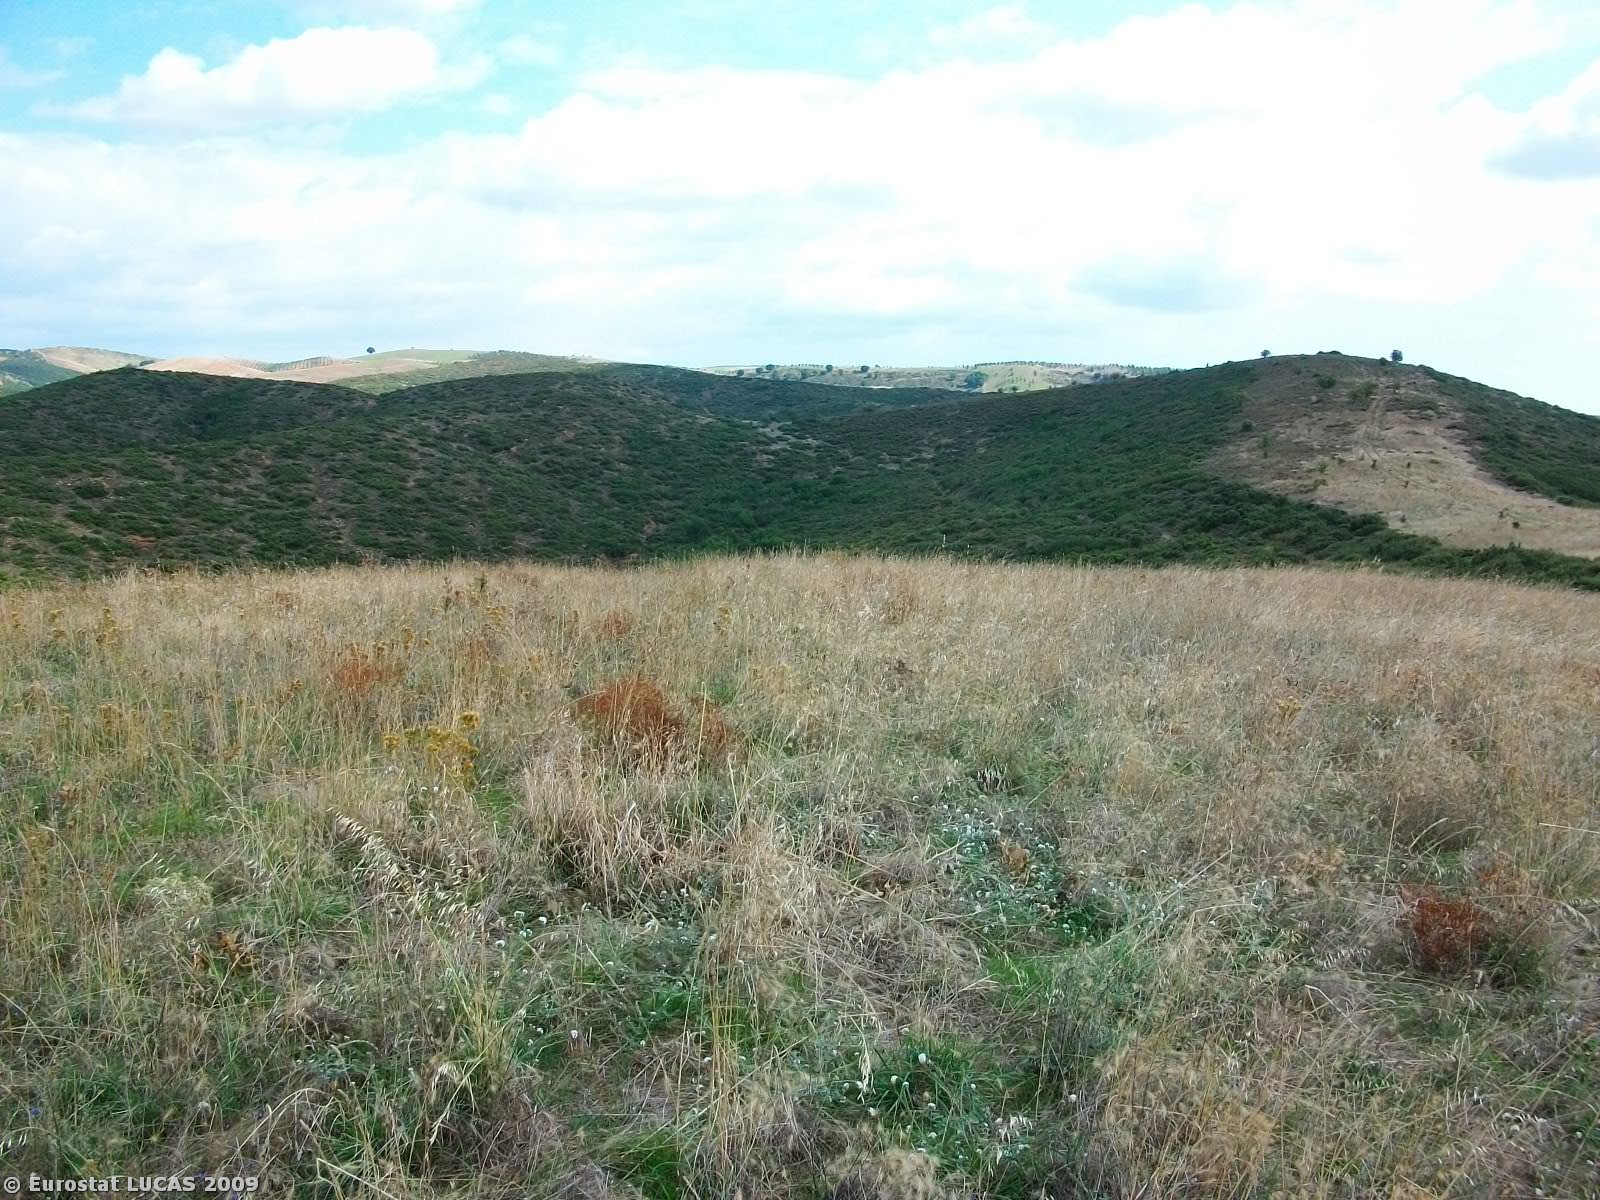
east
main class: Grassland
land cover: Grassland without tree/shrub cover
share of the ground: > 75 %
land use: Agriculture (excluding fallow land and kitchen gardens)
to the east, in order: Grassland without tree/shrub cover; Shrubland without tree cover; Rivers and streams; Shrubland with sparse tree cover; Shrubland without tree cover
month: September
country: GR
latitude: 39.4042
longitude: 22.5417
